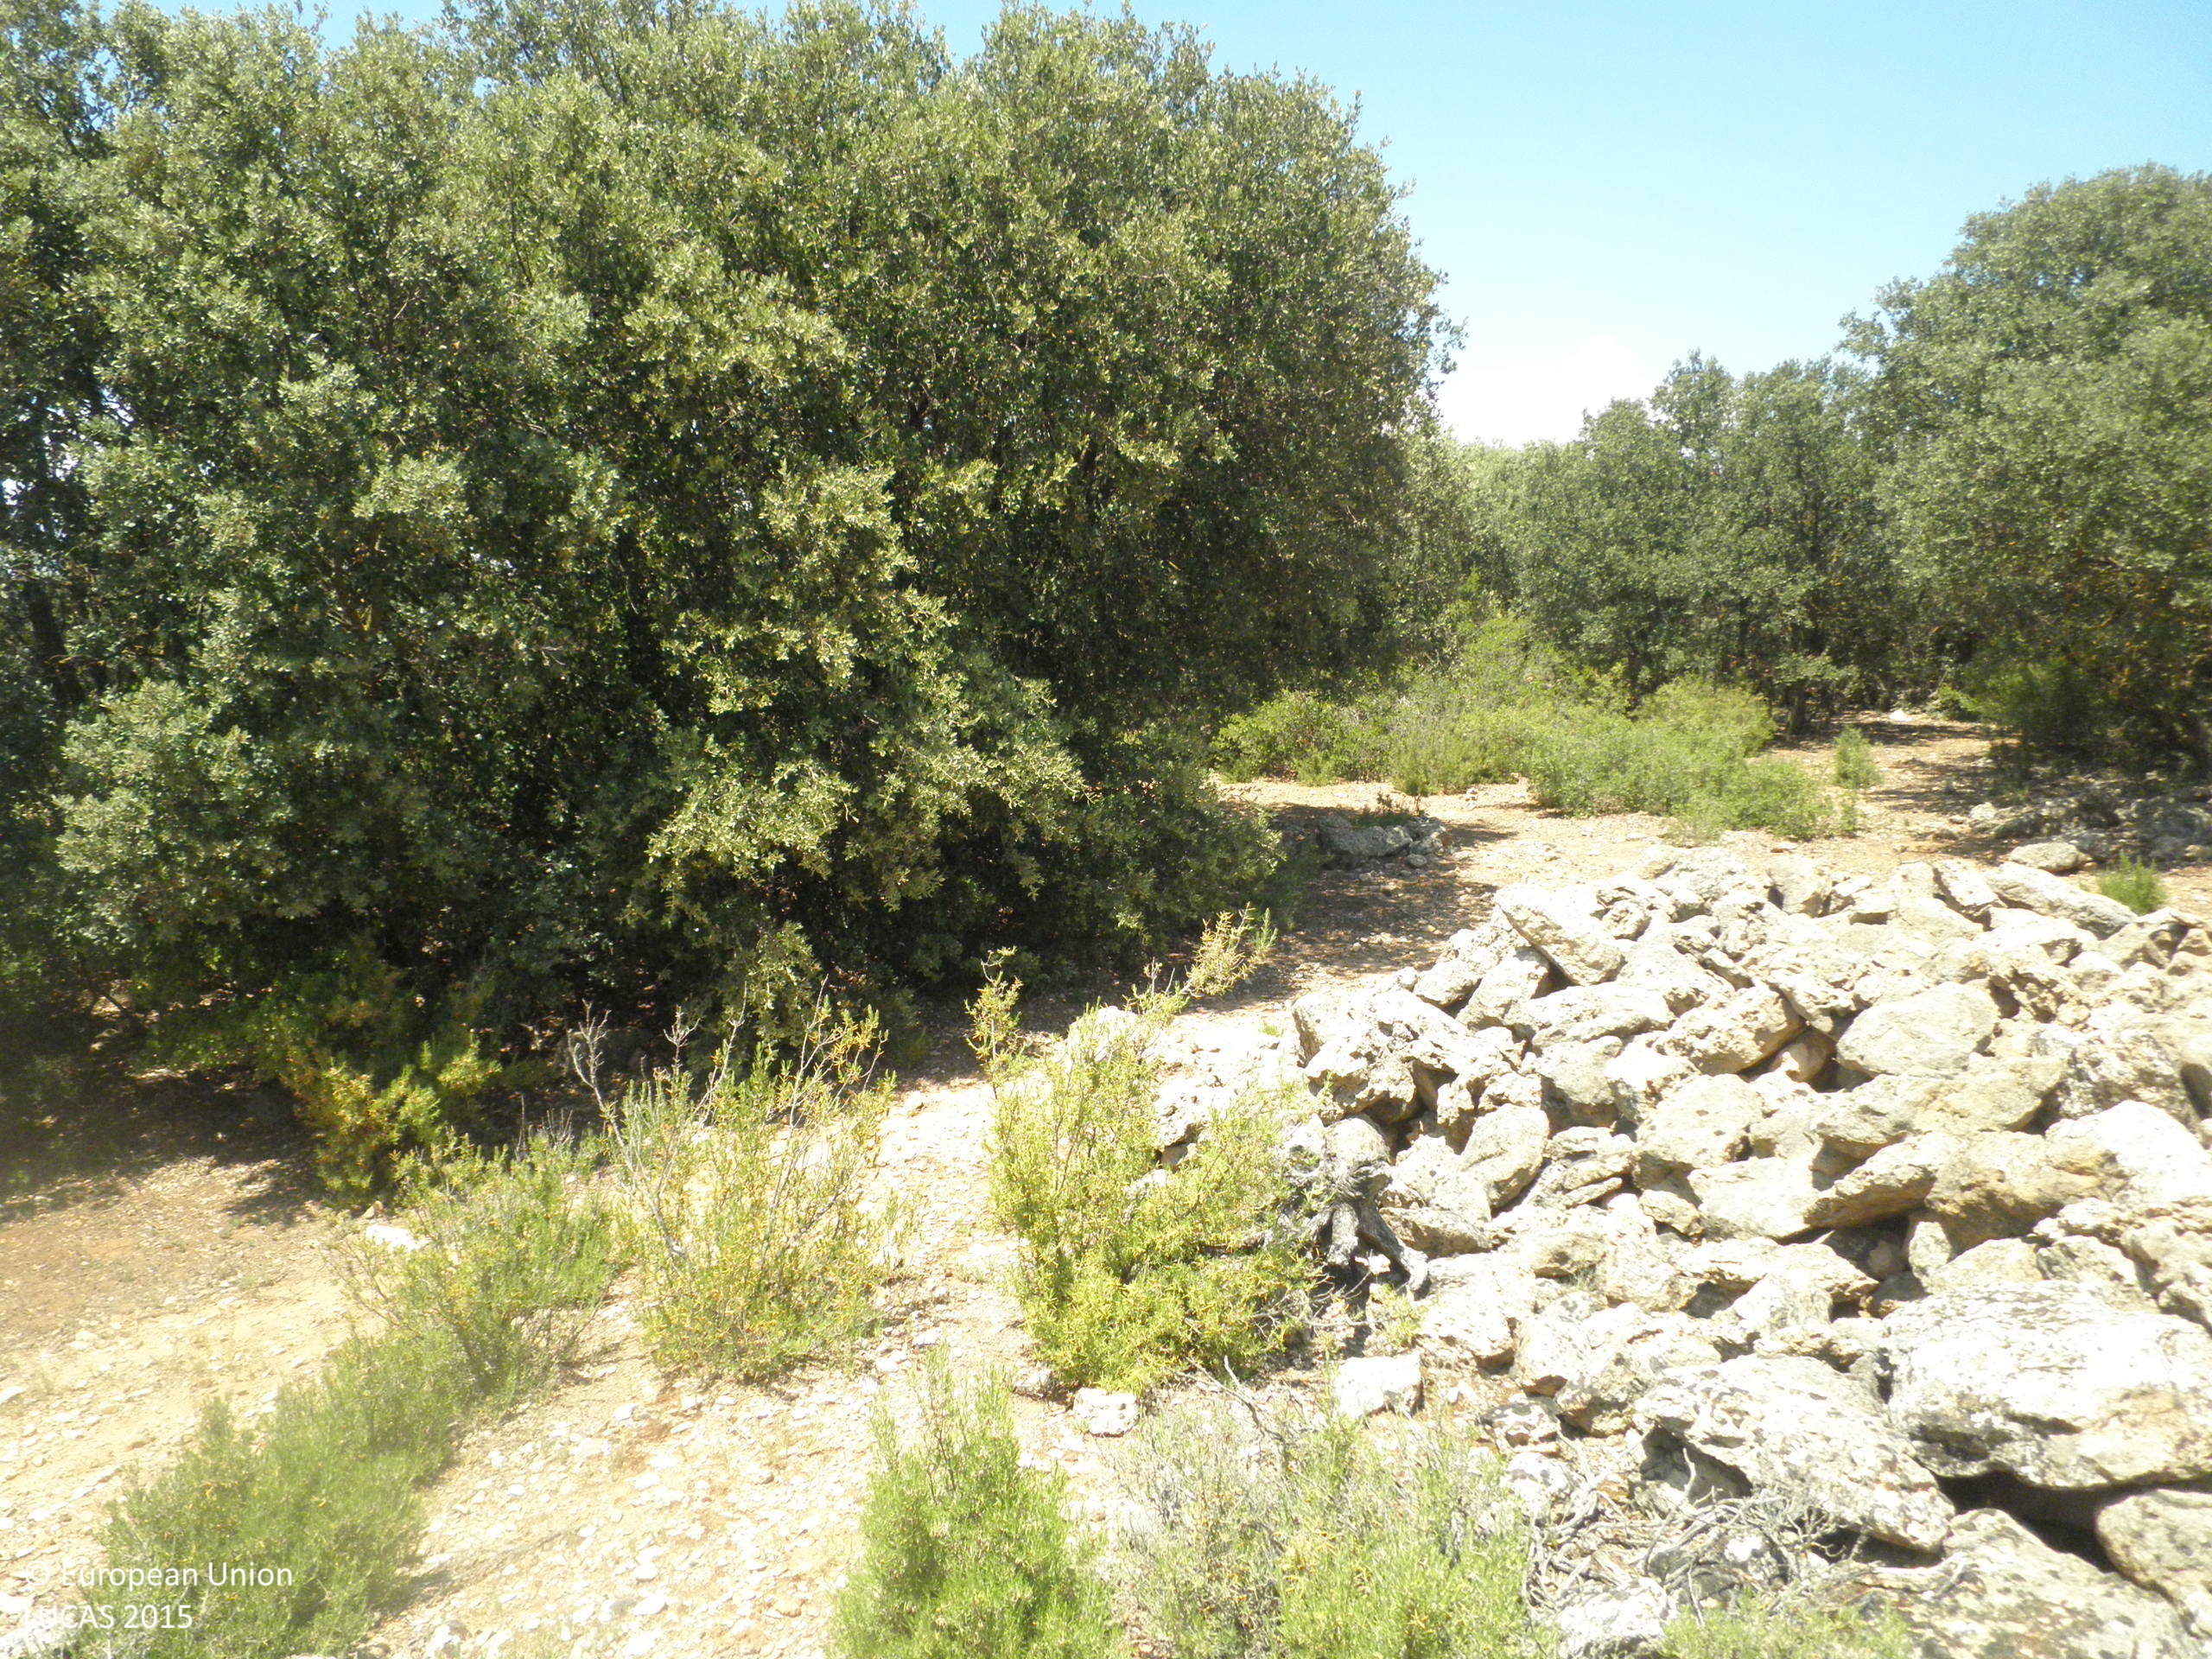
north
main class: Woodland
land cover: Broadleaved woodland
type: broadleaved evergreen forest
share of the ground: 25 - 50 %
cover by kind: unconsolidated bare surface 35 %, shrubs 30 %, broadleaved forest trees 25 %, consolidated bare surface 10 %
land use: Semi-natural and natural areas not in use
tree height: < 5 m
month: June
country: ES
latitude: 39.4900
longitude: -1.7141
